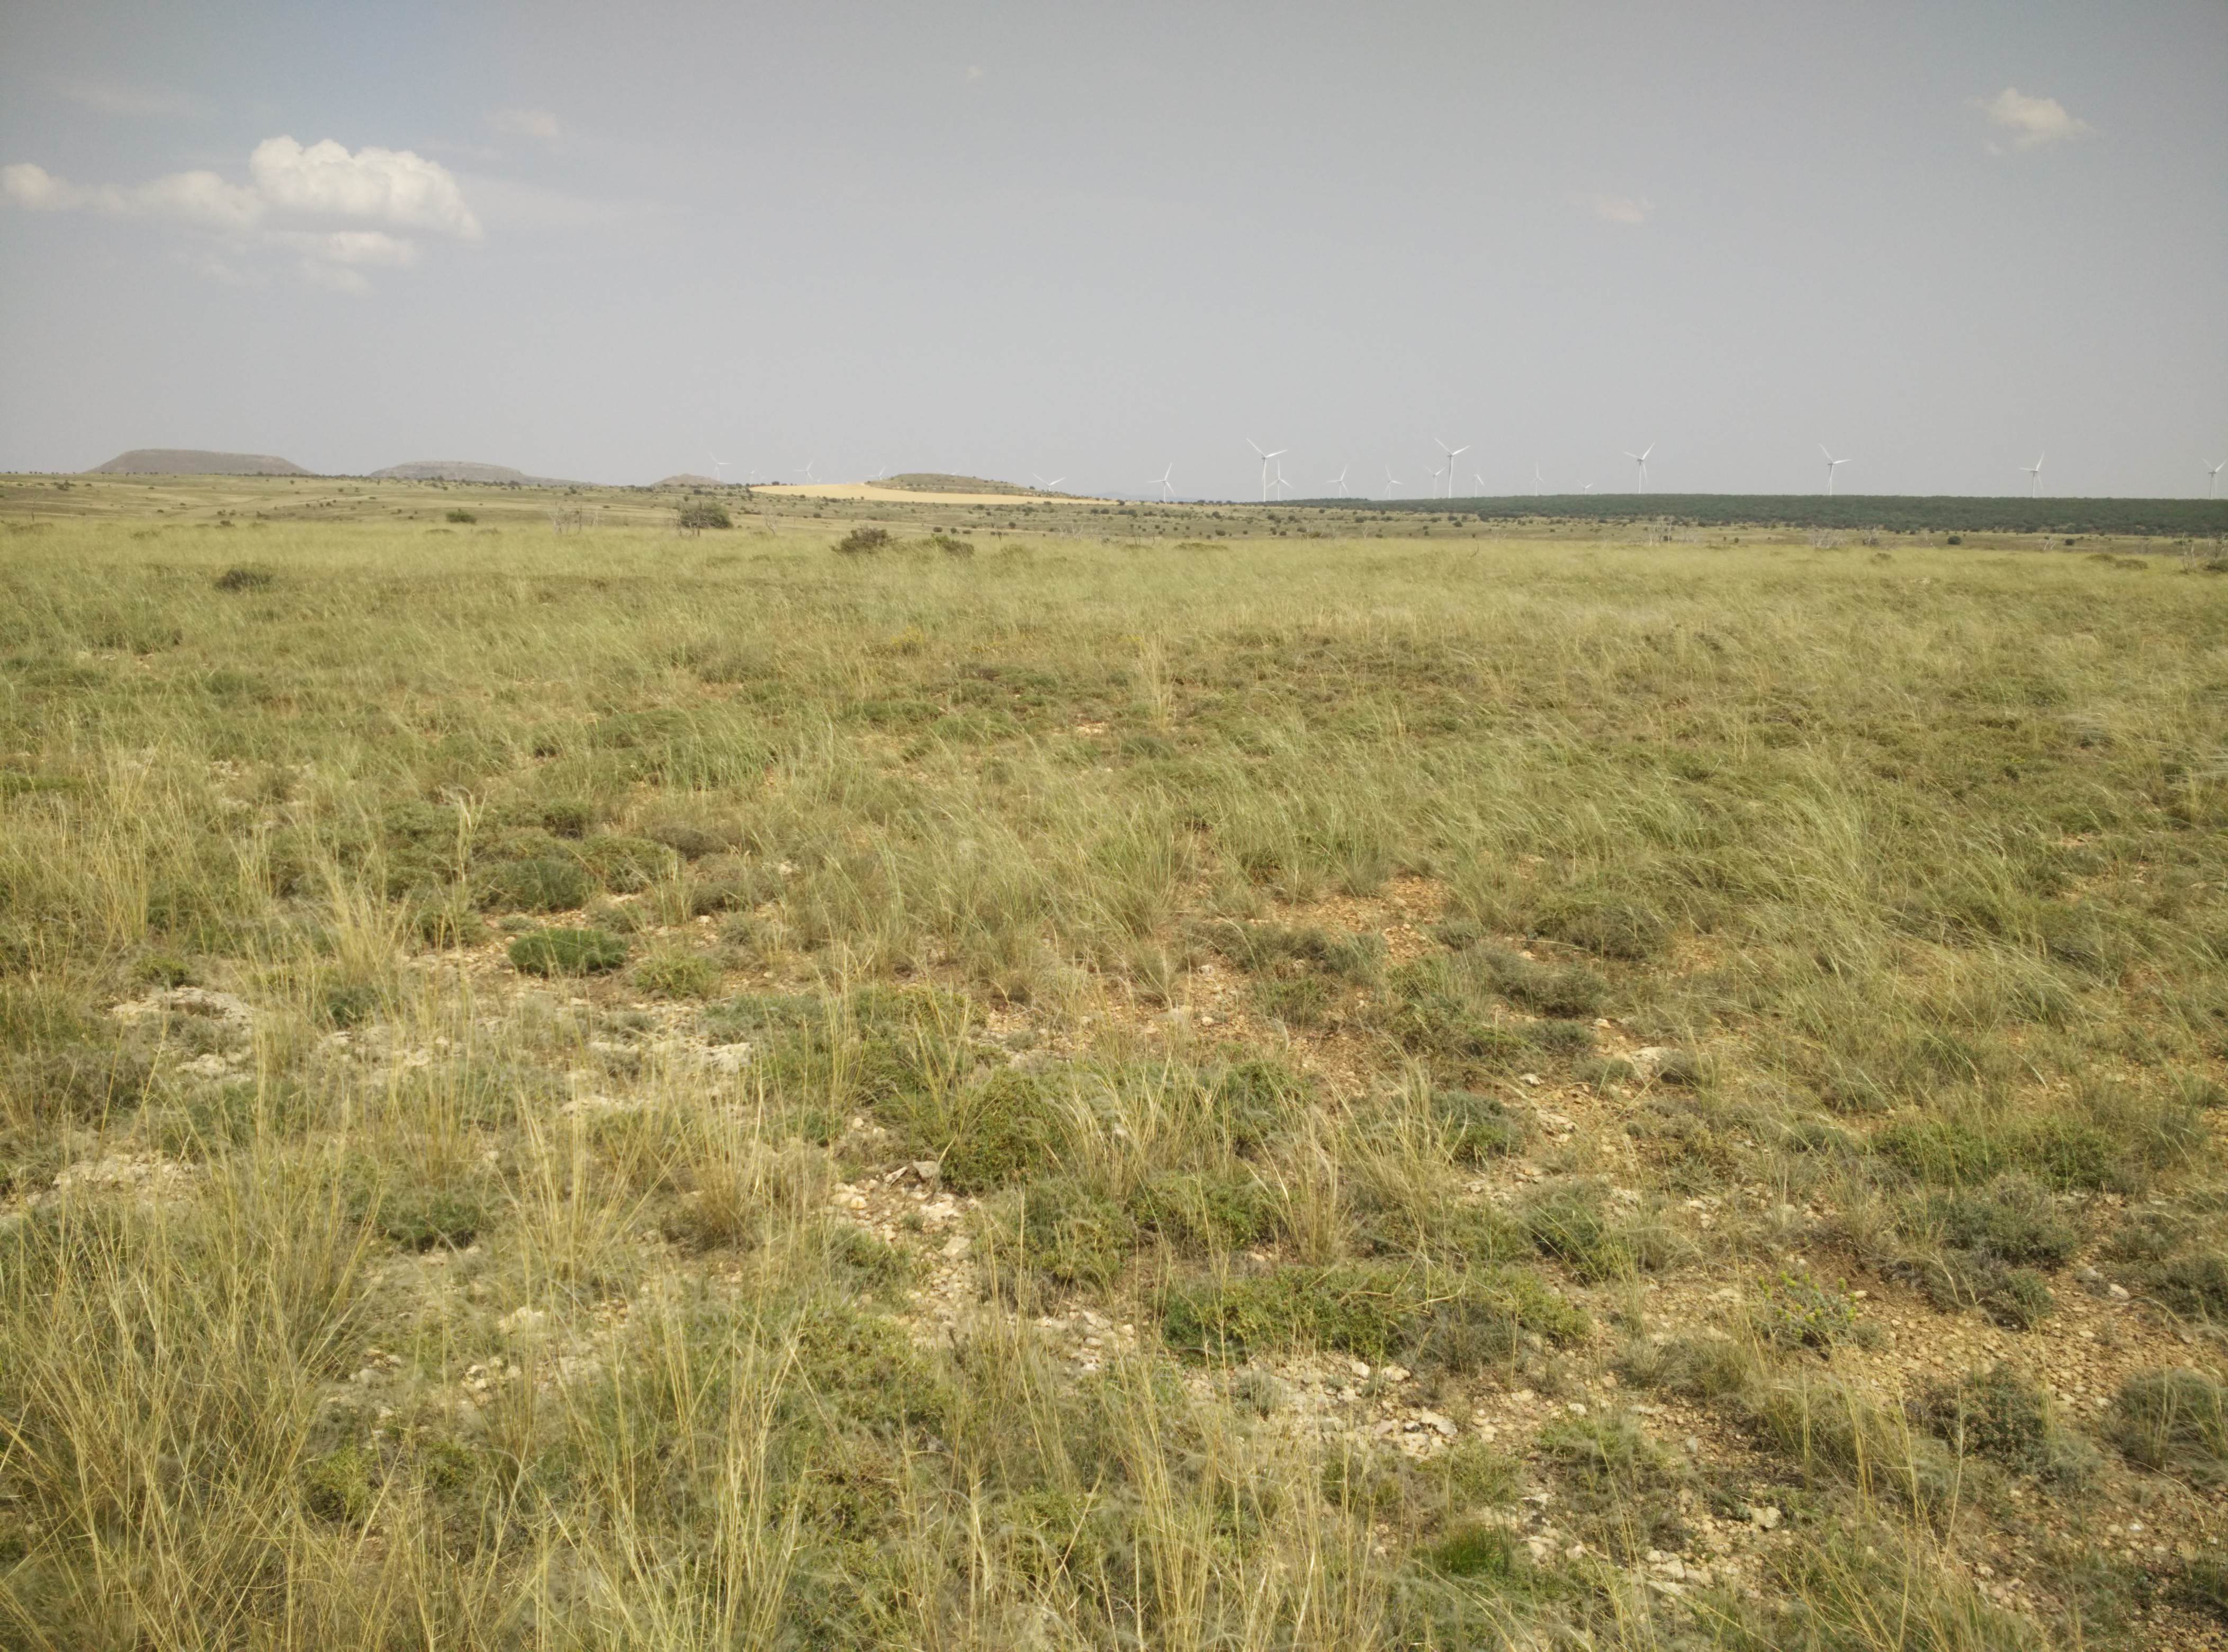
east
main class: Shrubland
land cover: Shrubland without tree cover
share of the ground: > 75 %
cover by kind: shrubs 80 %, unconsolidated bare surface 10 %, herbaceous plants 5 %, consolidated bare surface 5 %
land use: Semi-natural and natural areas not in use
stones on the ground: > 50 %
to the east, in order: Shrubland without tree cover
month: July
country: ES
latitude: 41.0189
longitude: -1.9042
